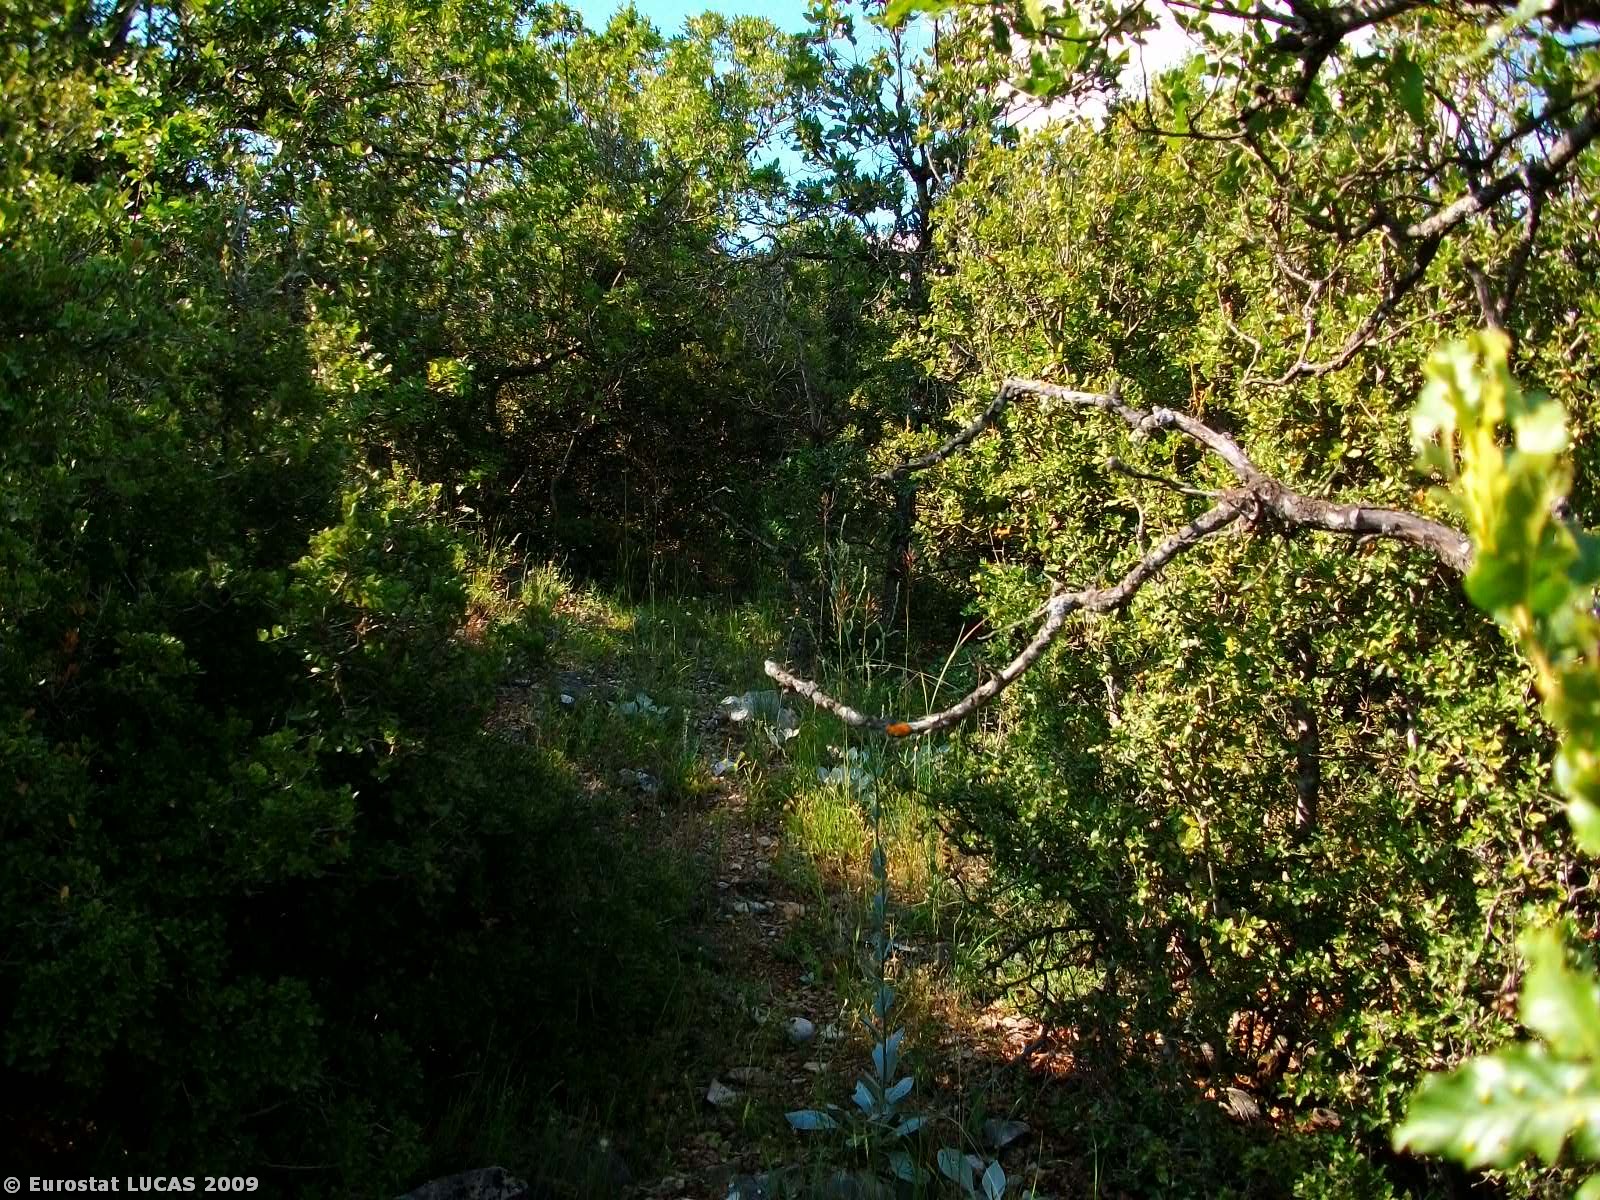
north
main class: Woodland
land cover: Broadleaved woodland
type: thermophilous deciduous forest
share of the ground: > 75 %
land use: Forestry
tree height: > 5 m
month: June
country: GR
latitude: 39.9959
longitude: 21.7594
